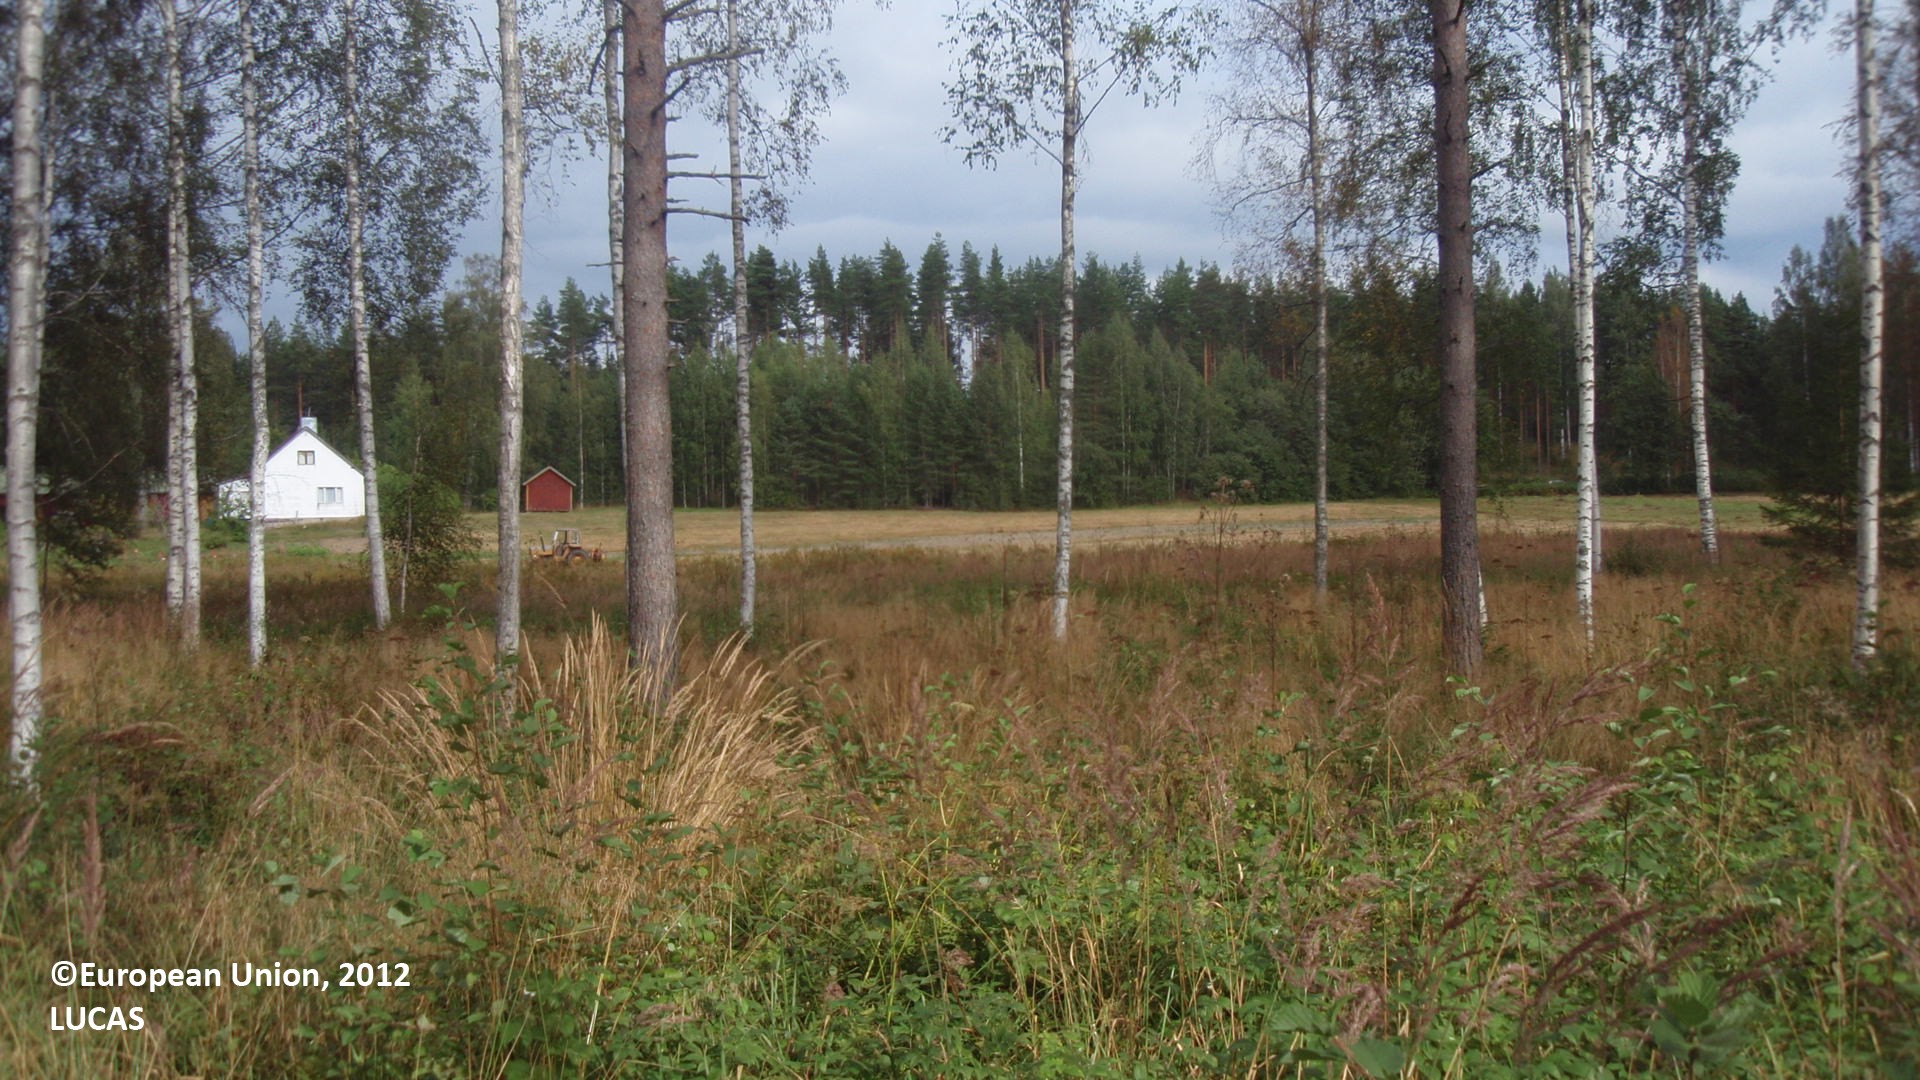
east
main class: Woodland
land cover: Broadleaved woodland
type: non-riverine alder, birch or aspen forest
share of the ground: 50 - 75 %
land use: Forestry
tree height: > 5 m
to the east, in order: Broadleaved woodland; Ditches and canals; Sand; Mixed cereals for fodder; Sand; Mixed cereals for fodder; Pine dominated mixed woodland; Broadleaved woodland; Paved roads, cycling and walking lanes; Broadleaved woodland; Pine dominated coniferous woodland
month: August
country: FI
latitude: 61.1540
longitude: 26.6739
